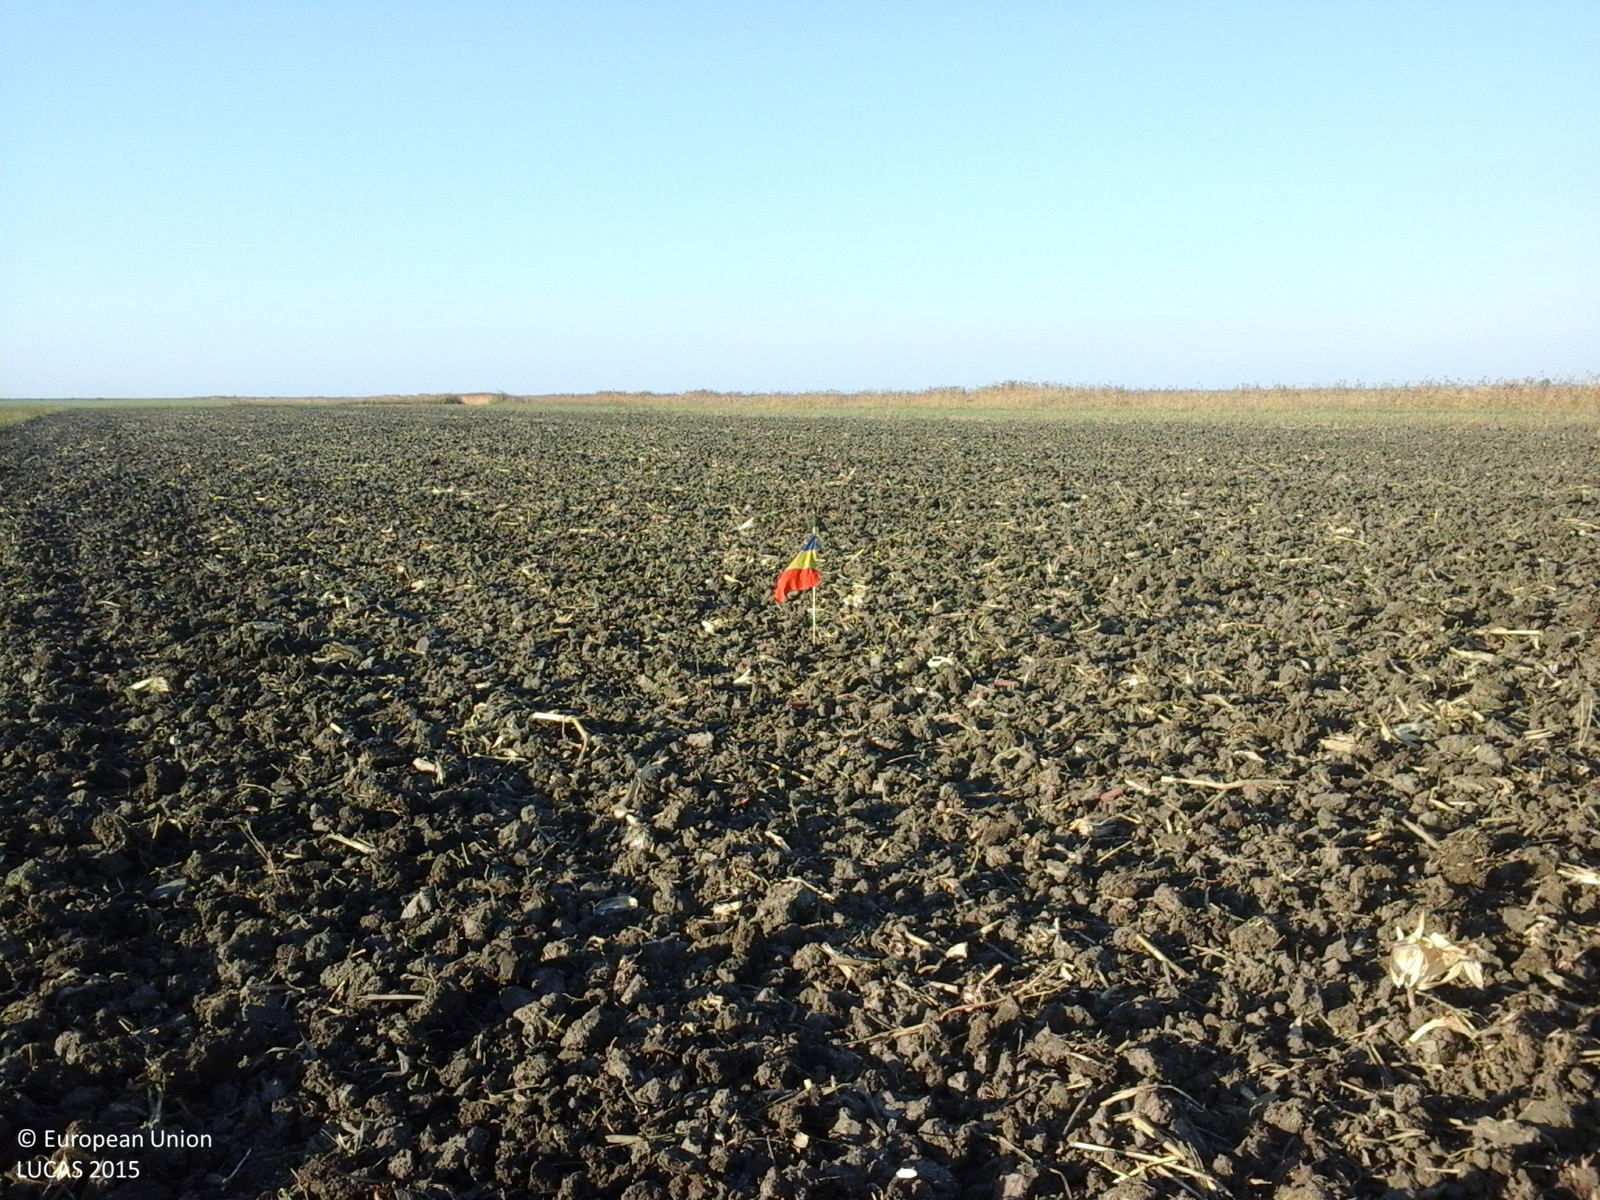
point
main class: Cropland
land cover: Maize
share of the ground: < 10 %
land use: Agriculture (excluding fallow land and kitchen gardens)
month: October
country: RO
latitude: 45.4110
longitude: 27.4915
